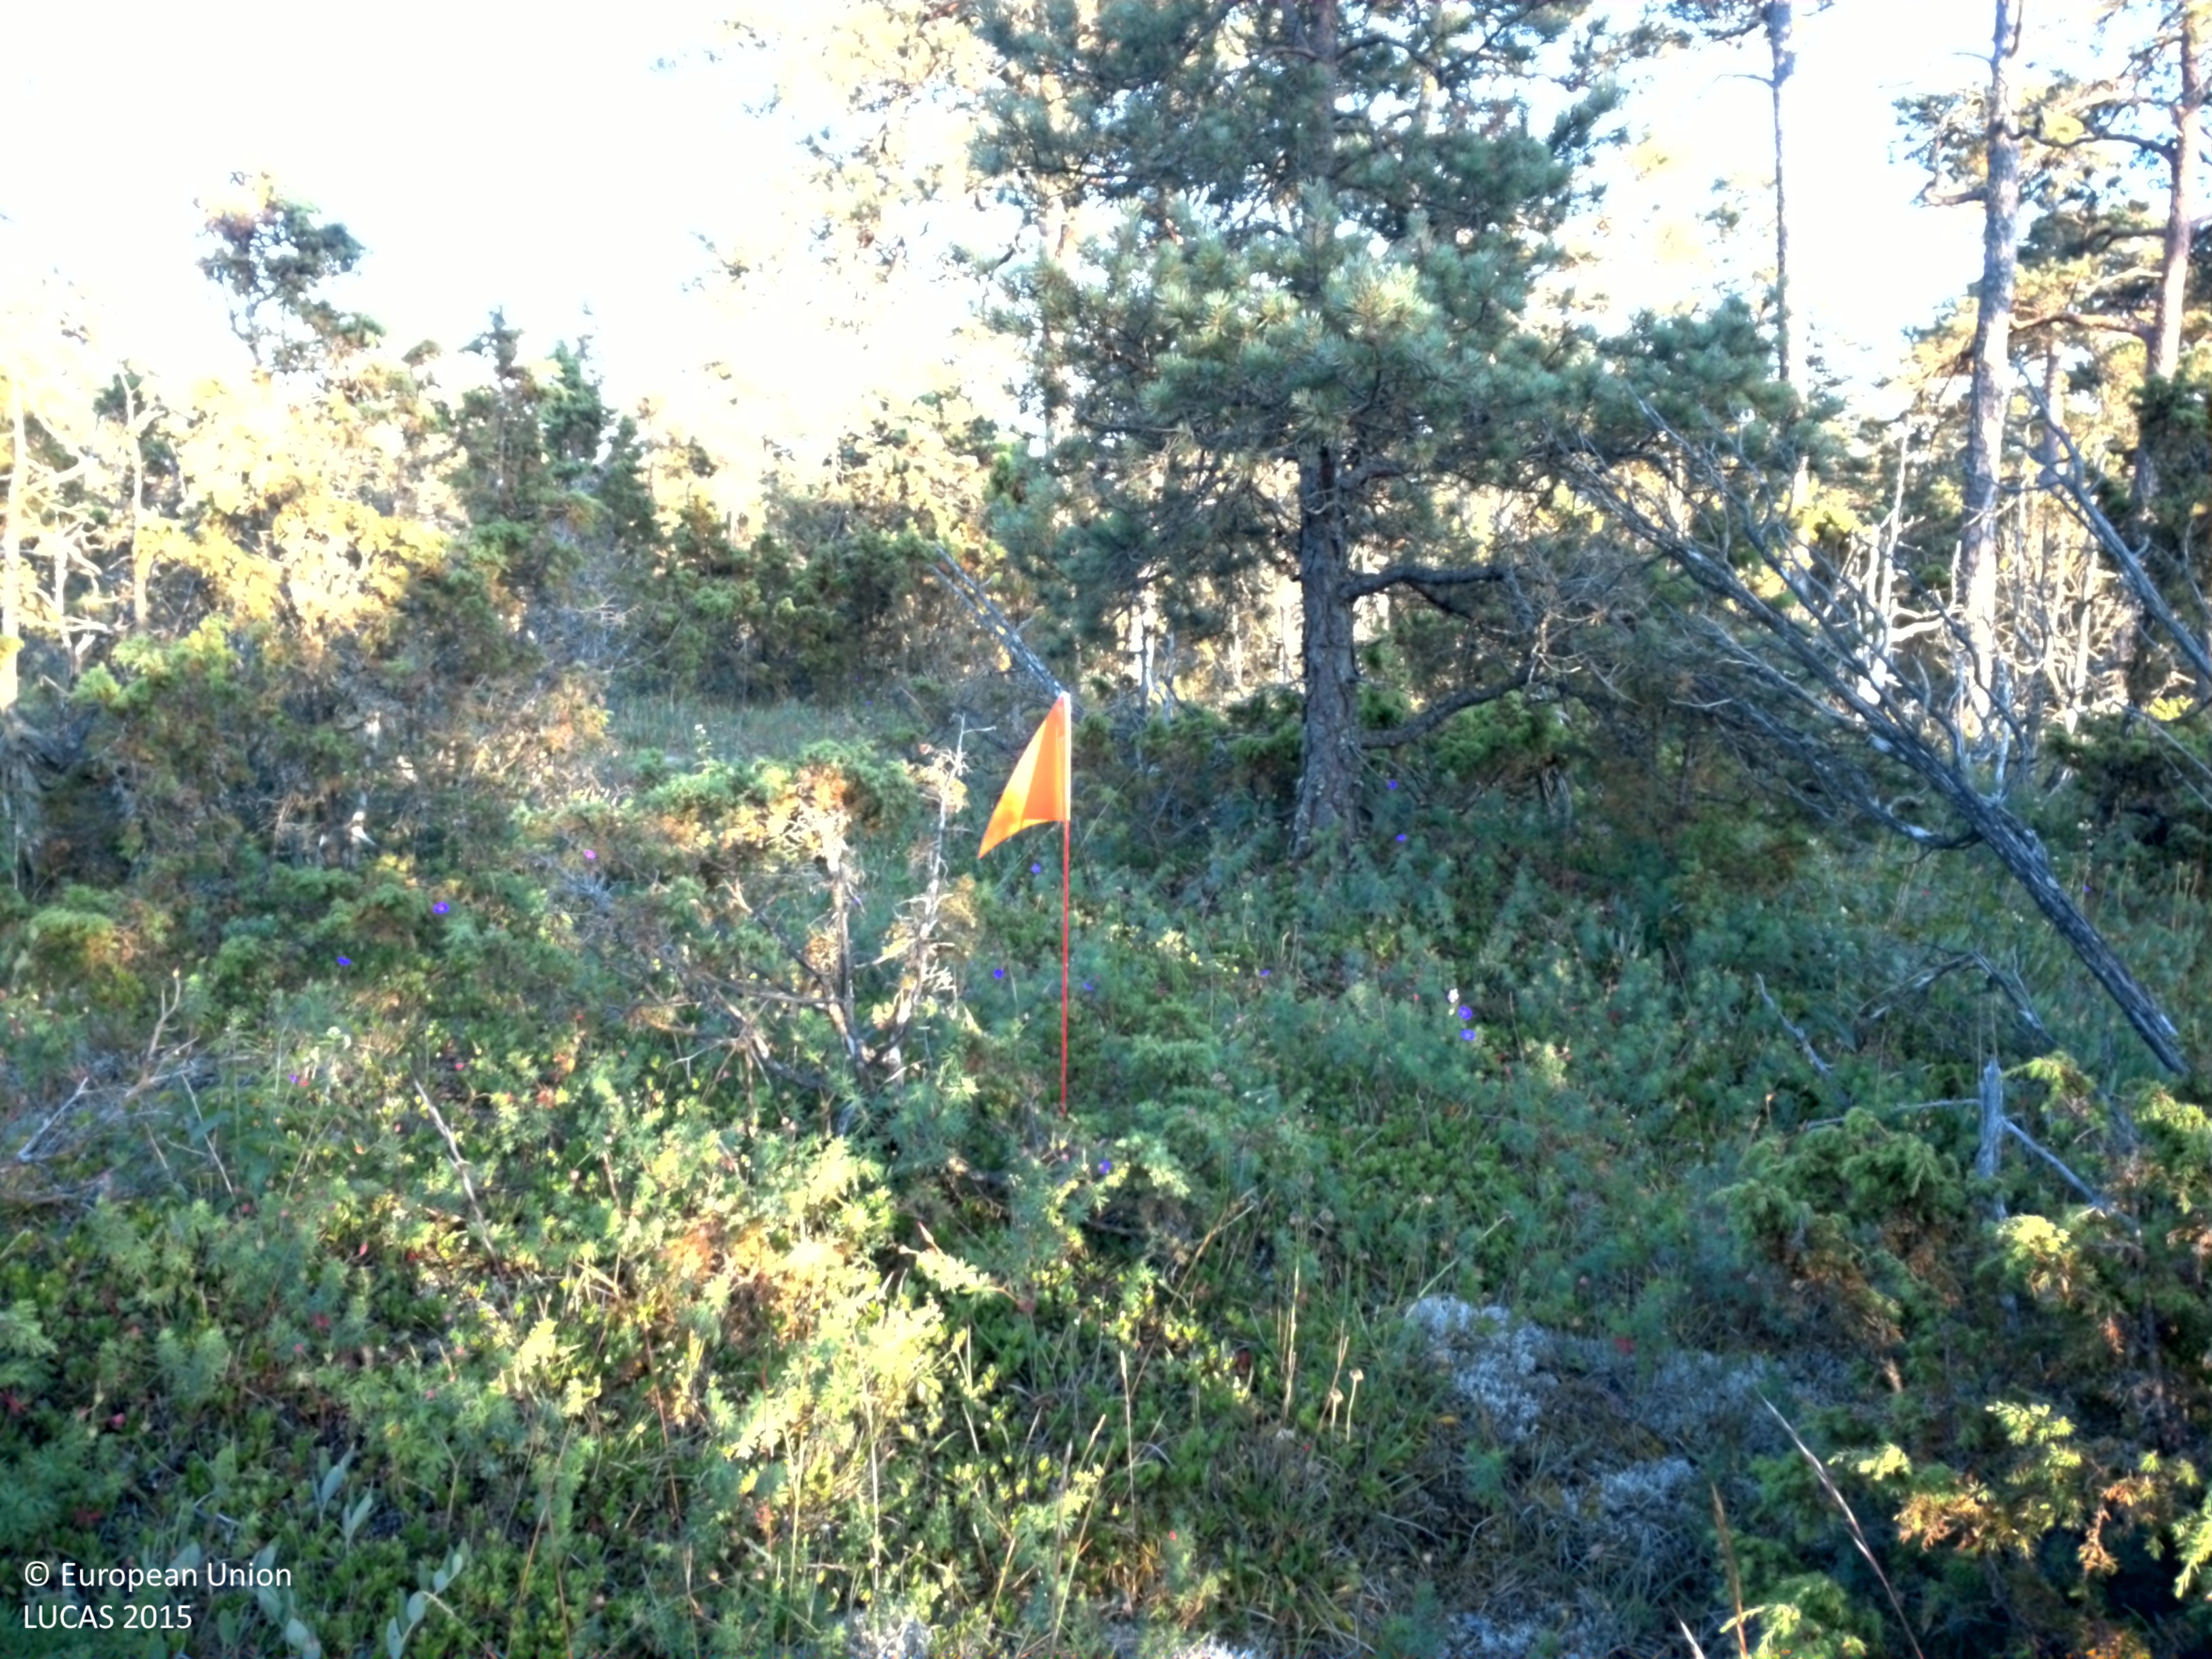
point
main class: Shrubland
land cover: Shrubland with sparse tree cover
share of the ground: > 75 %
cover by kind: shrubs 75 %, herbaceous plants 15 %, coniferous forest trees 5 %, lichens and mosses 5 %
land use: Semi-natural and natural areas not in use
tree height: > 5 m
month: July
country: SE
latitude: 57.3975
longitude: 18.6465
